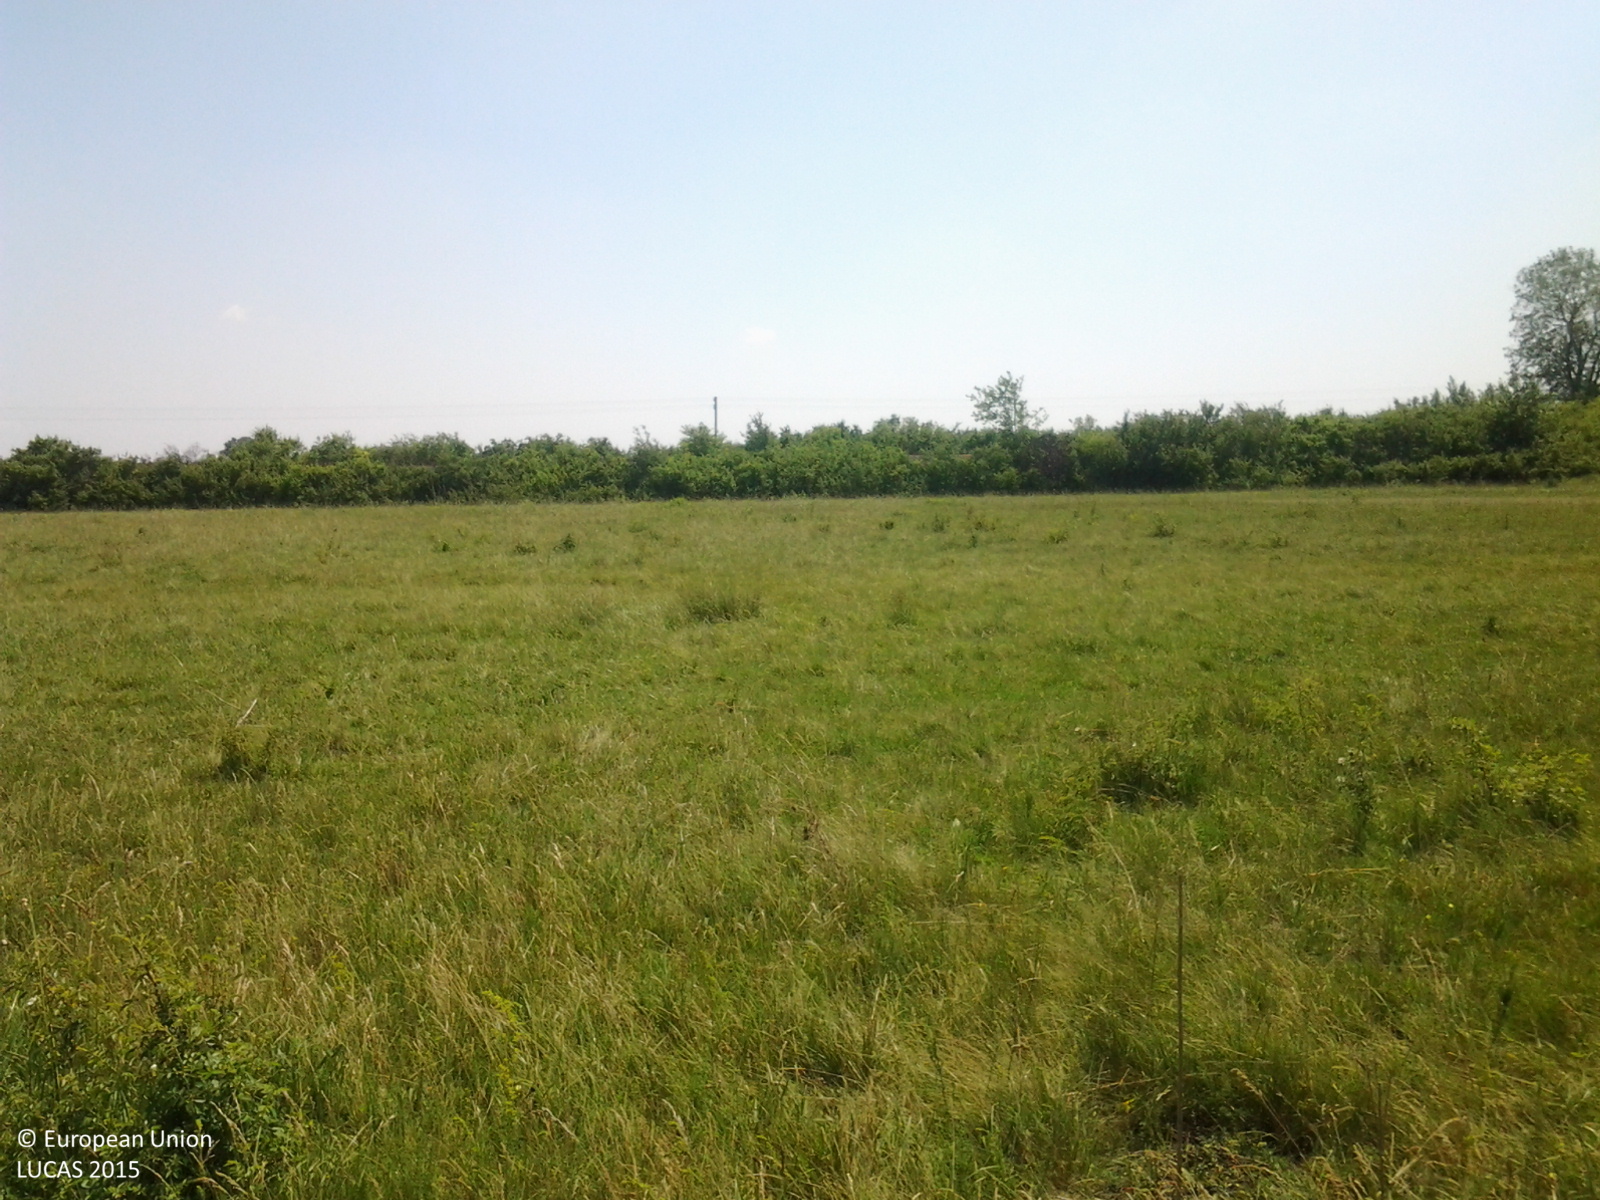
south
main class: Grassland
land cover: Grassland without tree/shrub cover
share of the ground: > 75 %
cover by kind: herbaceous plants 100 %
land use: Agriculture (excluding fallow land and kitchen gardens)
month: June
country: HU
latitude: 46.5243
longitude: 19.1006
